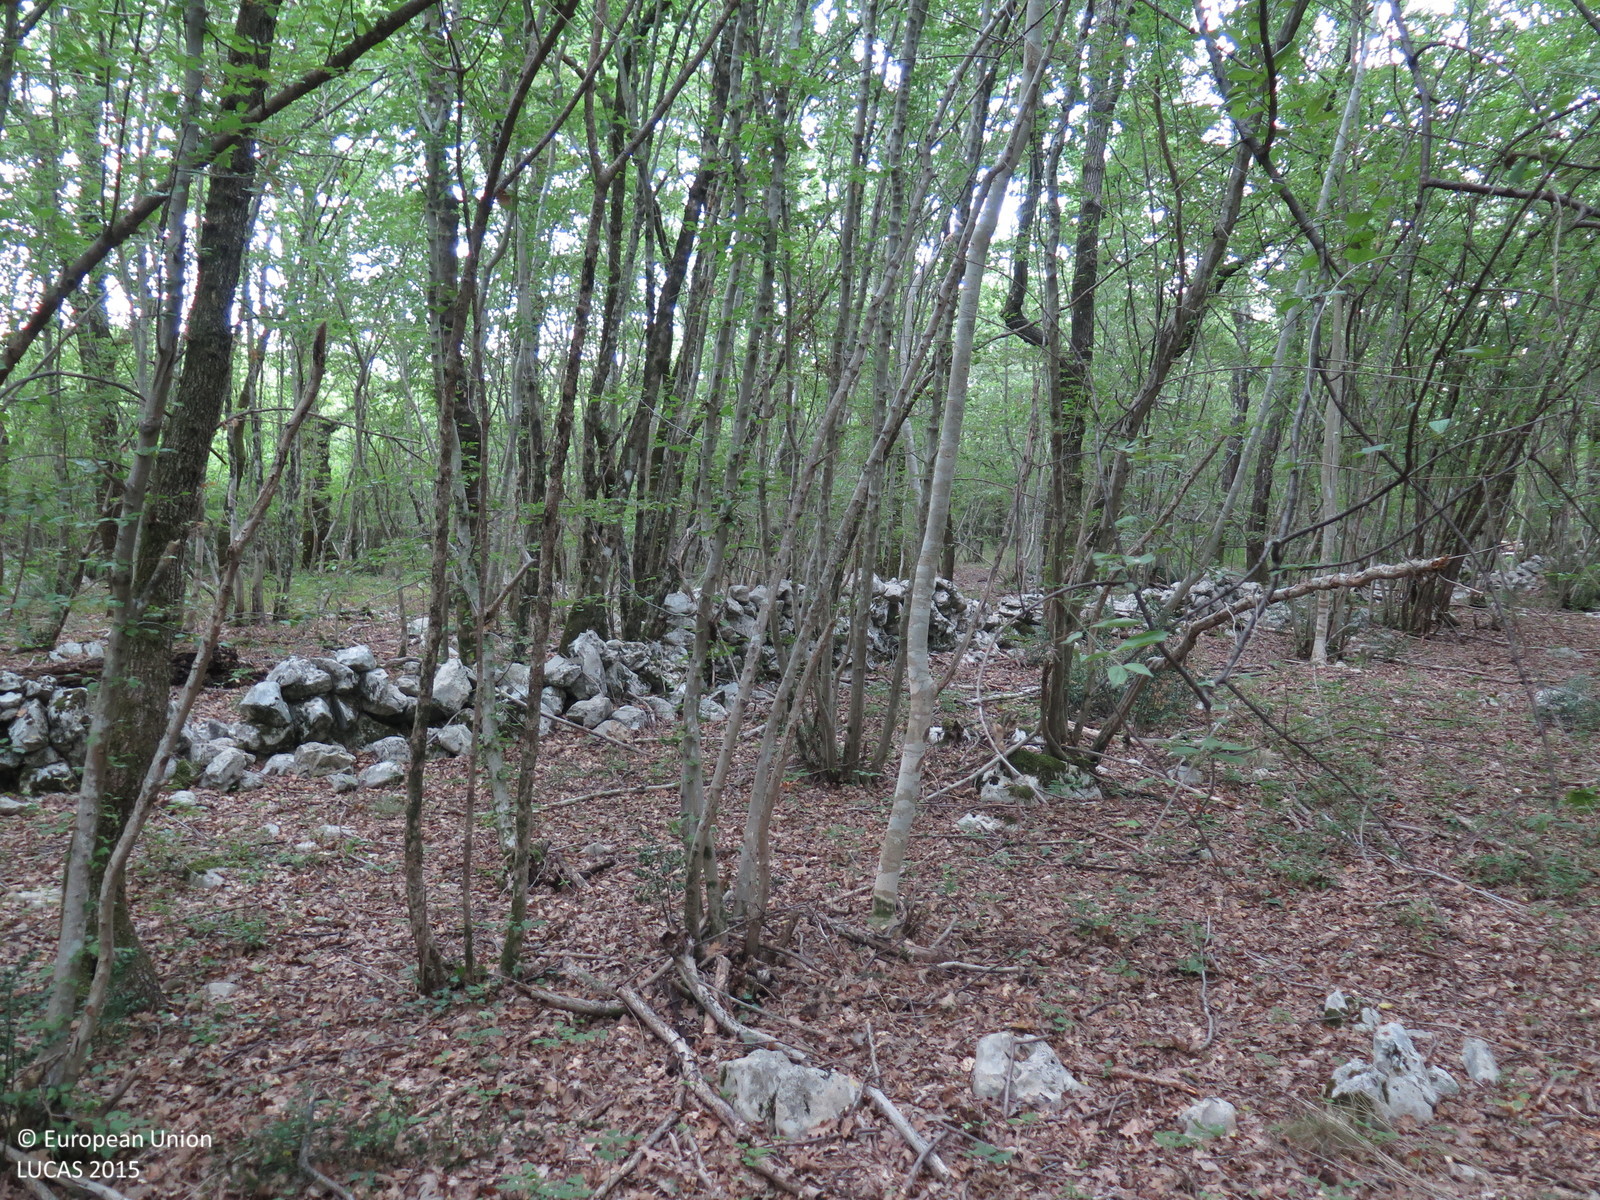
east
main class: Woodland
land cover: Broadleaved woodland
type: beech forest
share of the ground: > 75 %
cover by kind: broadleaved forest trees 100 %
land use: Semi-natural and natural areas not in use
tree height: > 5 m
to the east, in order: Broadleaved woodland; Dry stone walls; Broadleaved woodland; Dry stone walls; Broadleaved woodland; Dry stone walls; Managed hedges; Grass margins; Tracks; Grass margins; Dry stone walls; Managed hedges; Grassland without tree/shrub cover; Broadleaved woodland; Dry stone walls; Grassland without tree/shrub cover; Managed hedges; Dry stone walls; Electric lines; Shrubland with sparse tree cover; Broadleaved woodland
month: August
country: HR
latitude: 45.1139
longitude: 14.6341
